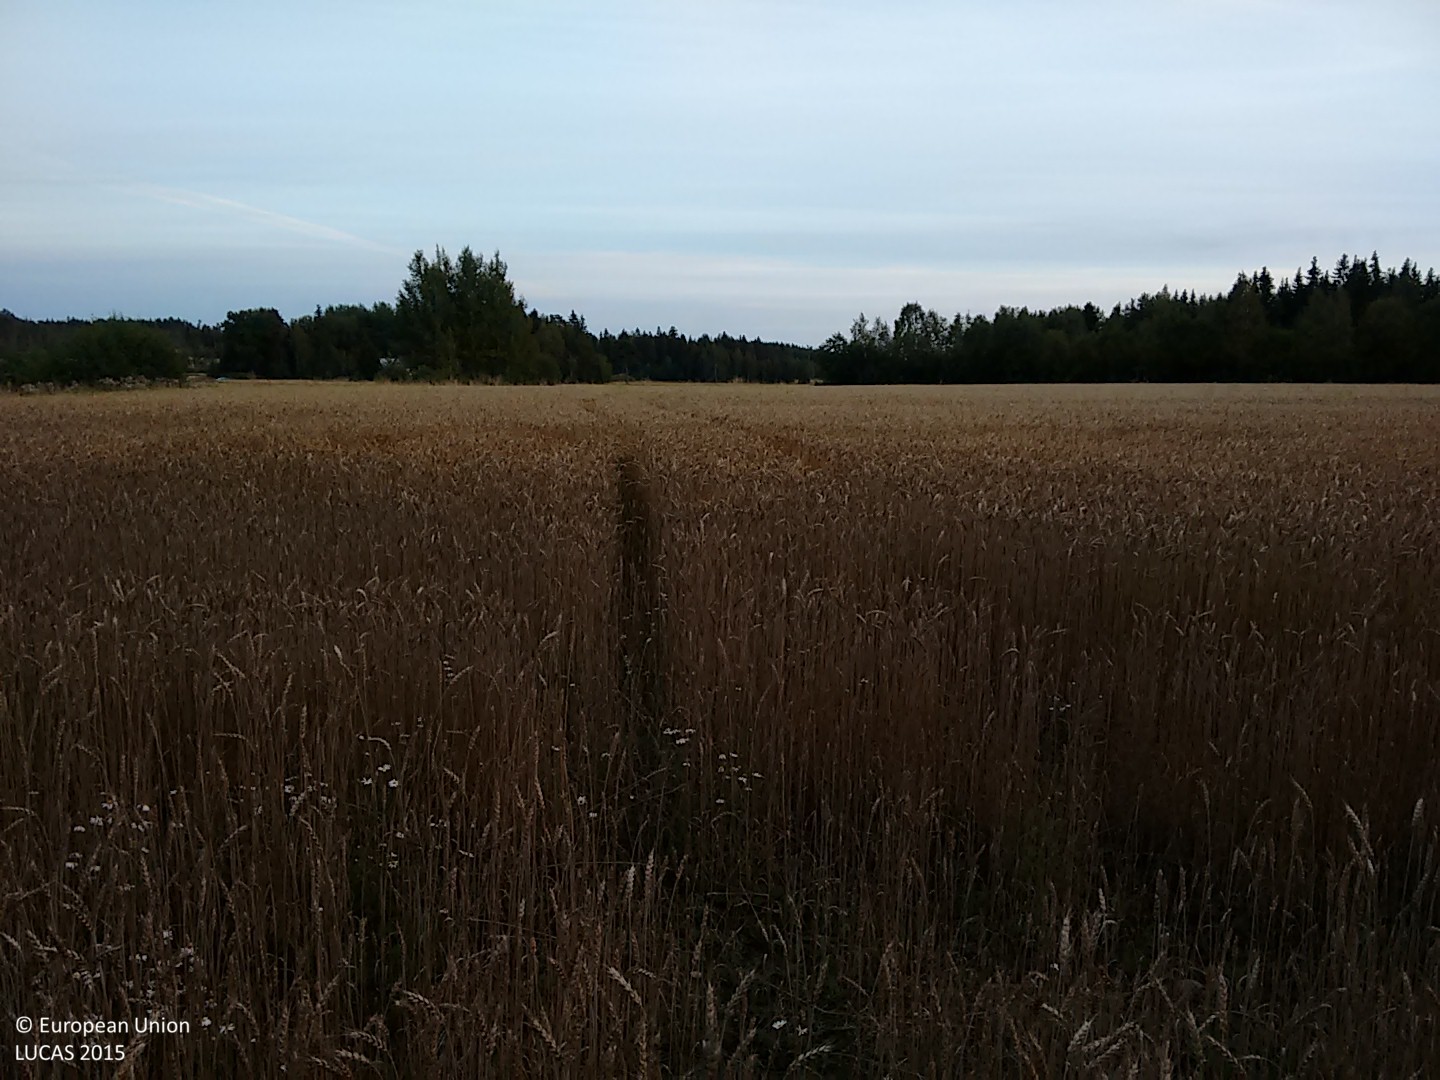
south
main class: Cropland
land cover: Common wheat
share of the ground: > 75 %
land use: Agriculture (excluding fallow land and kitchen gardens)
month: September
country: FI
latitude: 60.8754
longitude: 21.9401
